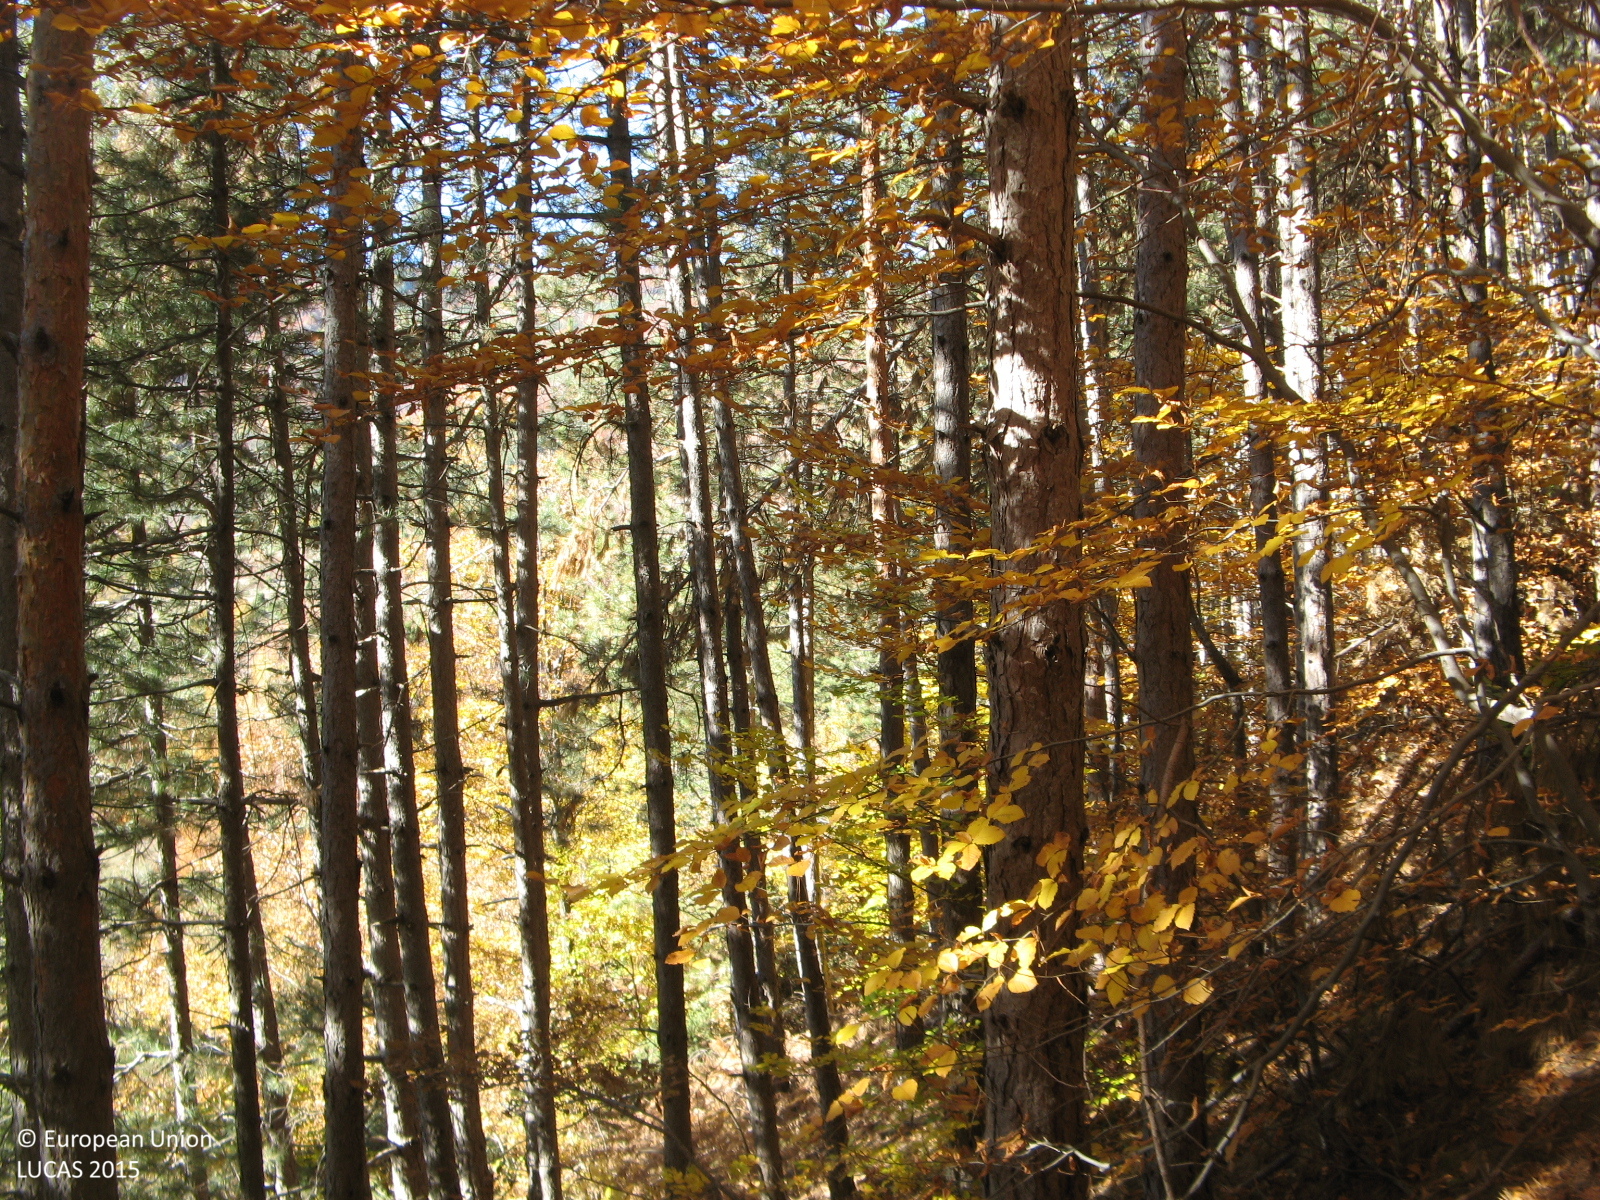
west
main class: Woodland
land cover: Pine dominated mixed woodland
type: hemiboreal forest and nemoral coniferous forest and mixed broadleaved-coniferous forest
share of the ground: > 75 %
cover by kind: coniferous forest trees 75 %, broadleaved forest trees 25 %
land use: Forestry
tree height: > 5 m
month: November
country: BG
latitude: 41.5268
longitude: 25.1394
